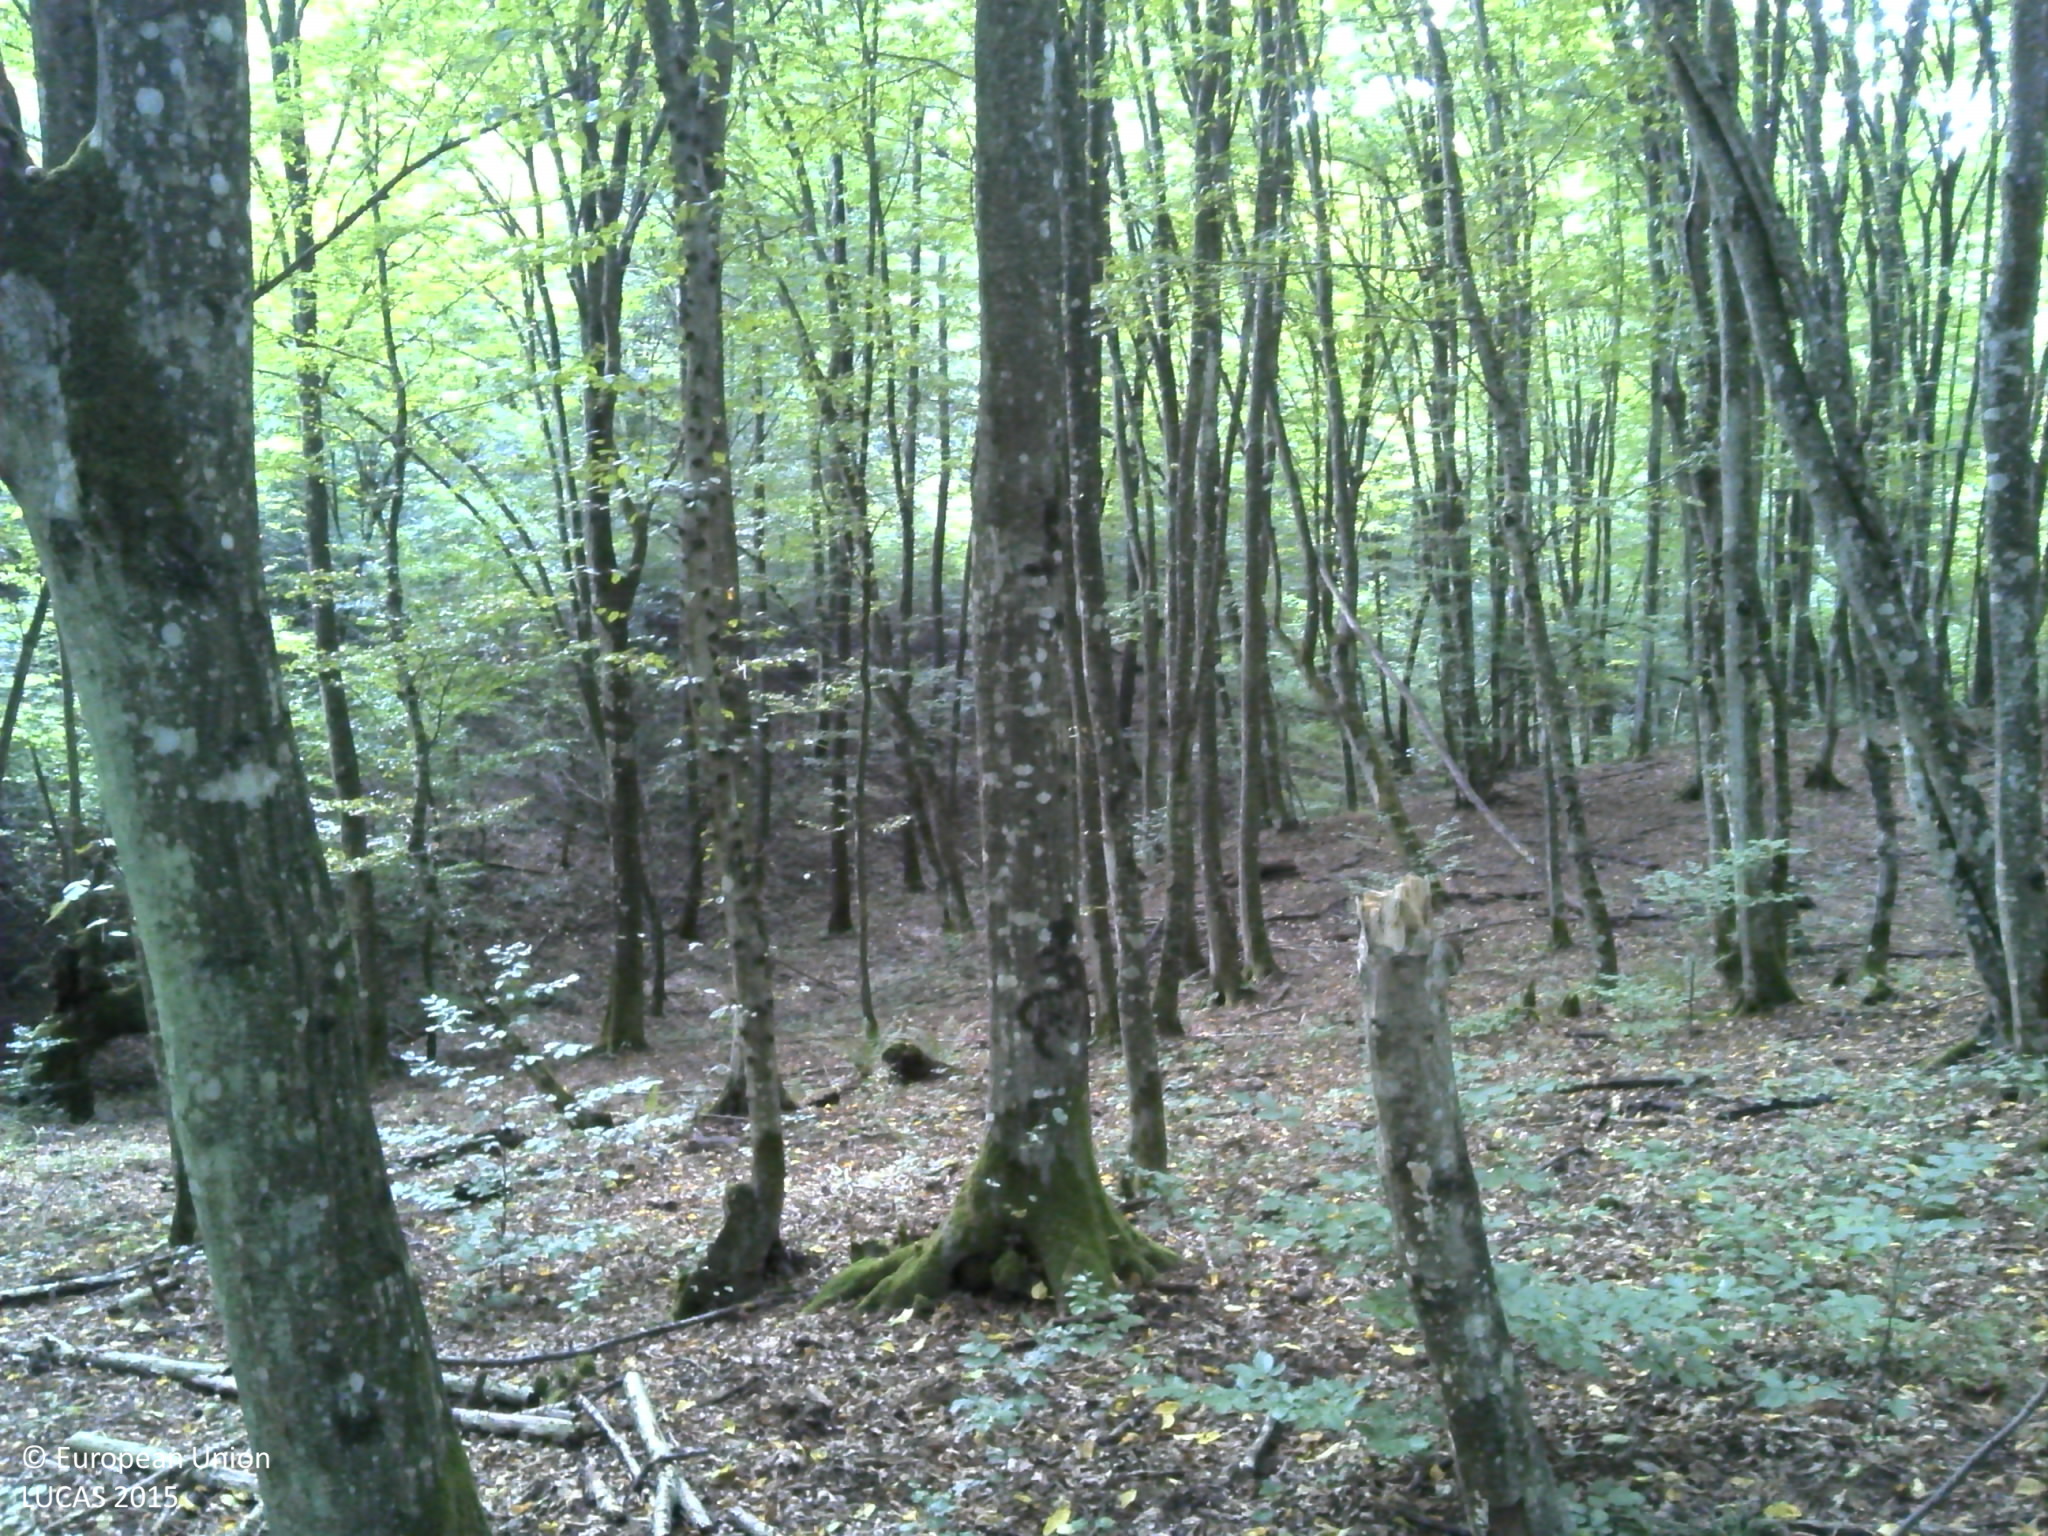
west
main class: Woodland
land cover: Broadleaved woodland
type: beech forest
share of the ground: > 75 %
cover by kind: broadleaved forest trees 100 %
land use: Forestry
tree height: > 5 m
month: August
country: HR
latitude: 45.2202
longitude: 16.6835
